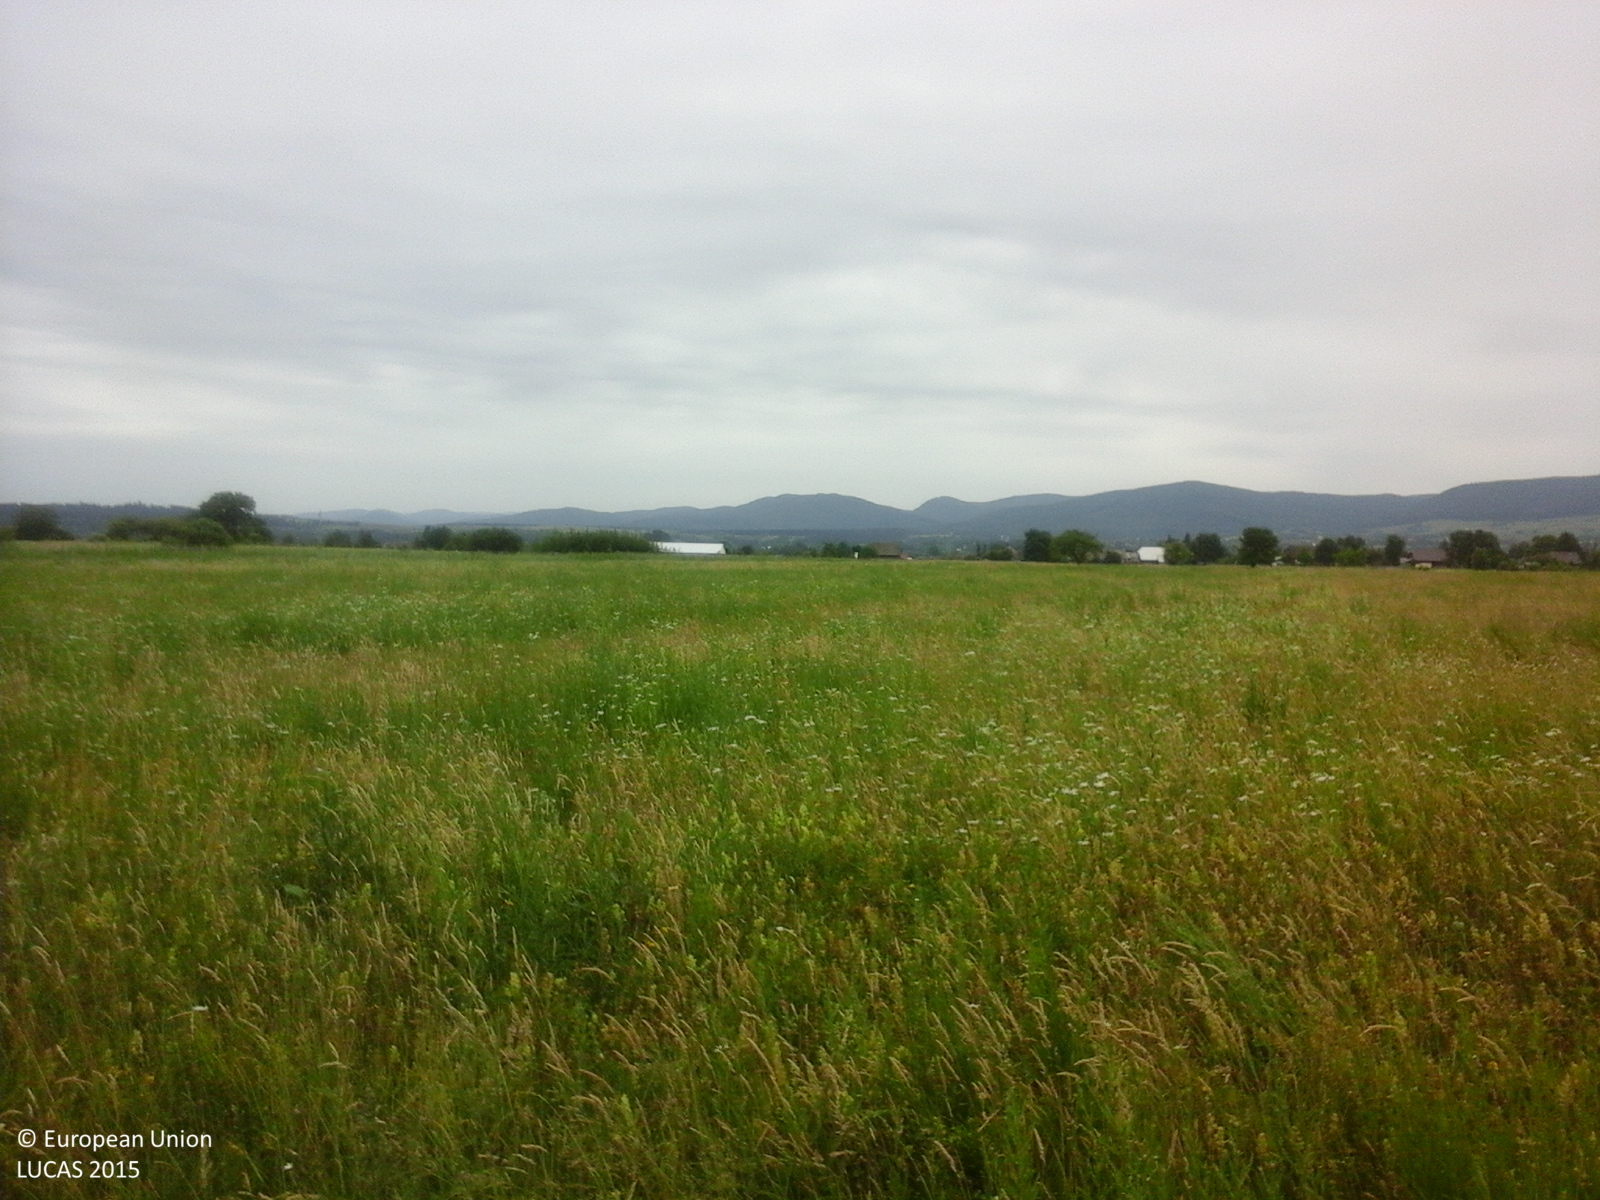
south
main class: Grassland
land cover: Grassland without tree/shrub cover
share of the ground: > 75 %
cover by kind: herbaceous plants 100 %
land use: Agriculture (excluding fallow land and kitchen gardens)
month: June
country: RO
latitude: 47.9300
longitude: 25.7174
